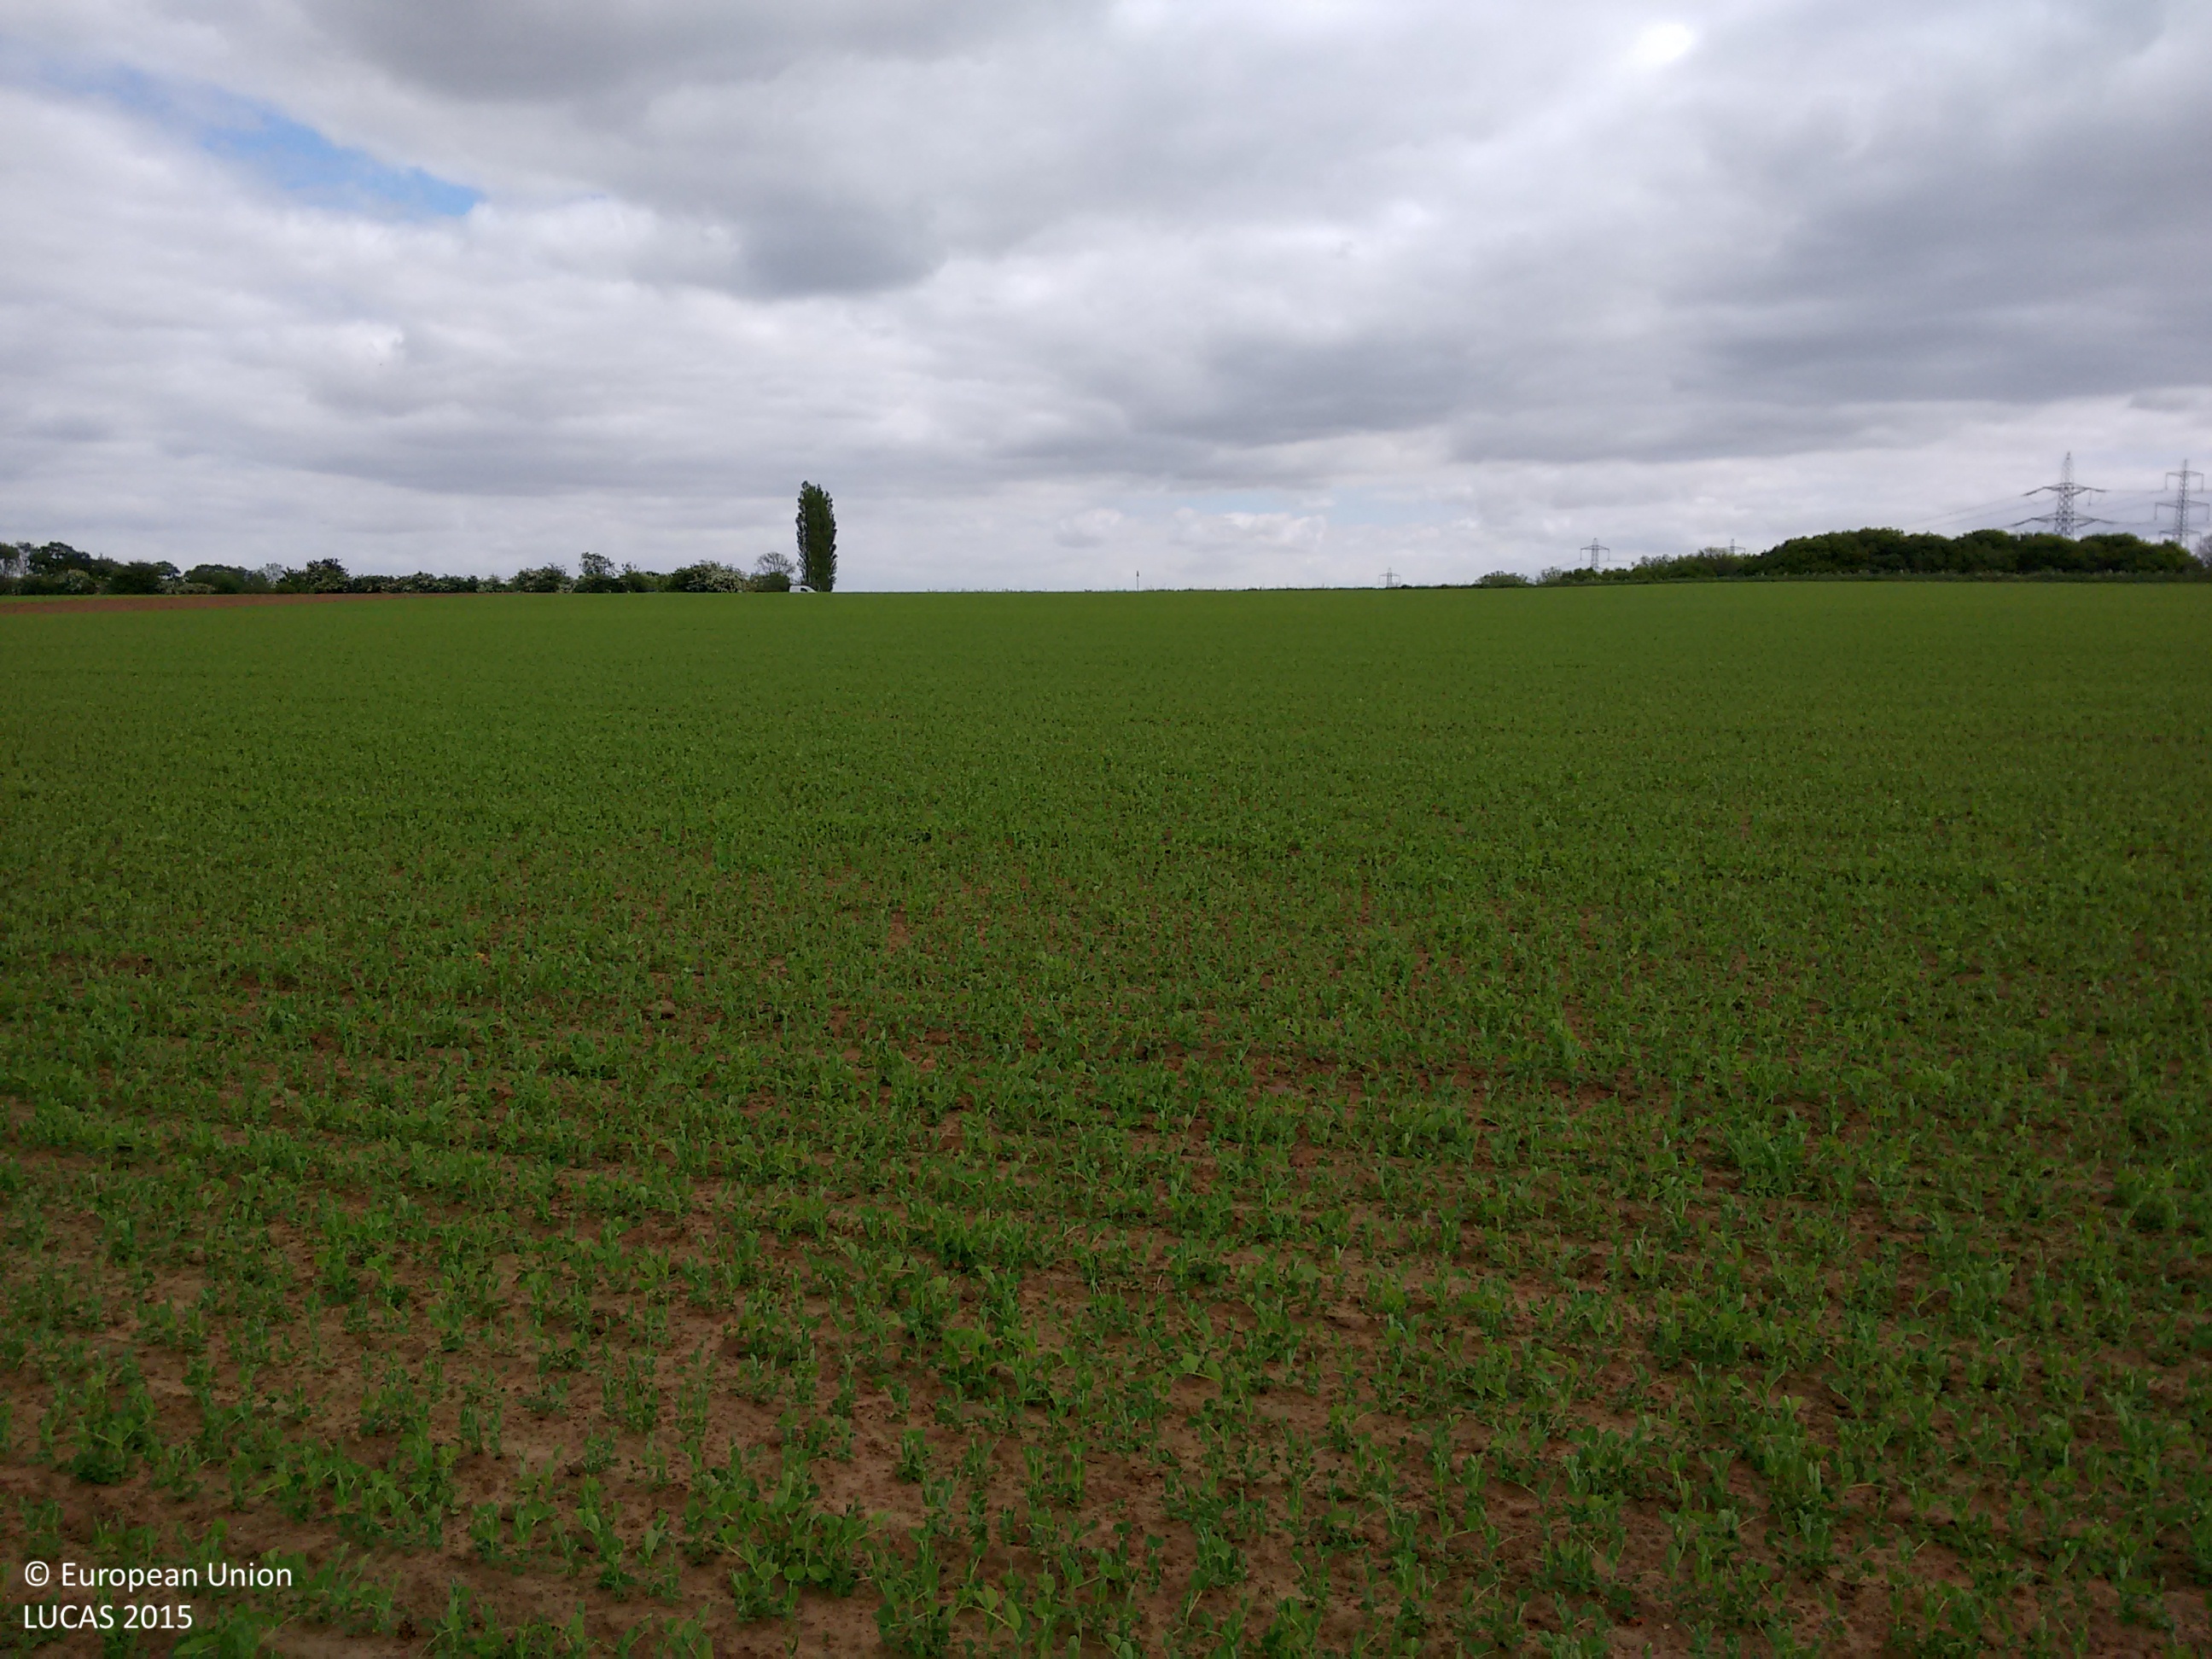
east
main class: Cropland
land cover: Dry pulses
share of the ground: 25 - 50 %
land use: Agriculture (excluding fallow land and kitchen gardens)
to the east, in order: Dry pulses; Grass margins; Paved roads, cycling and walking lanes; Grass margins; Barley
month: May
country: GB
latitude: 53.6720
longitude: -0.6803
